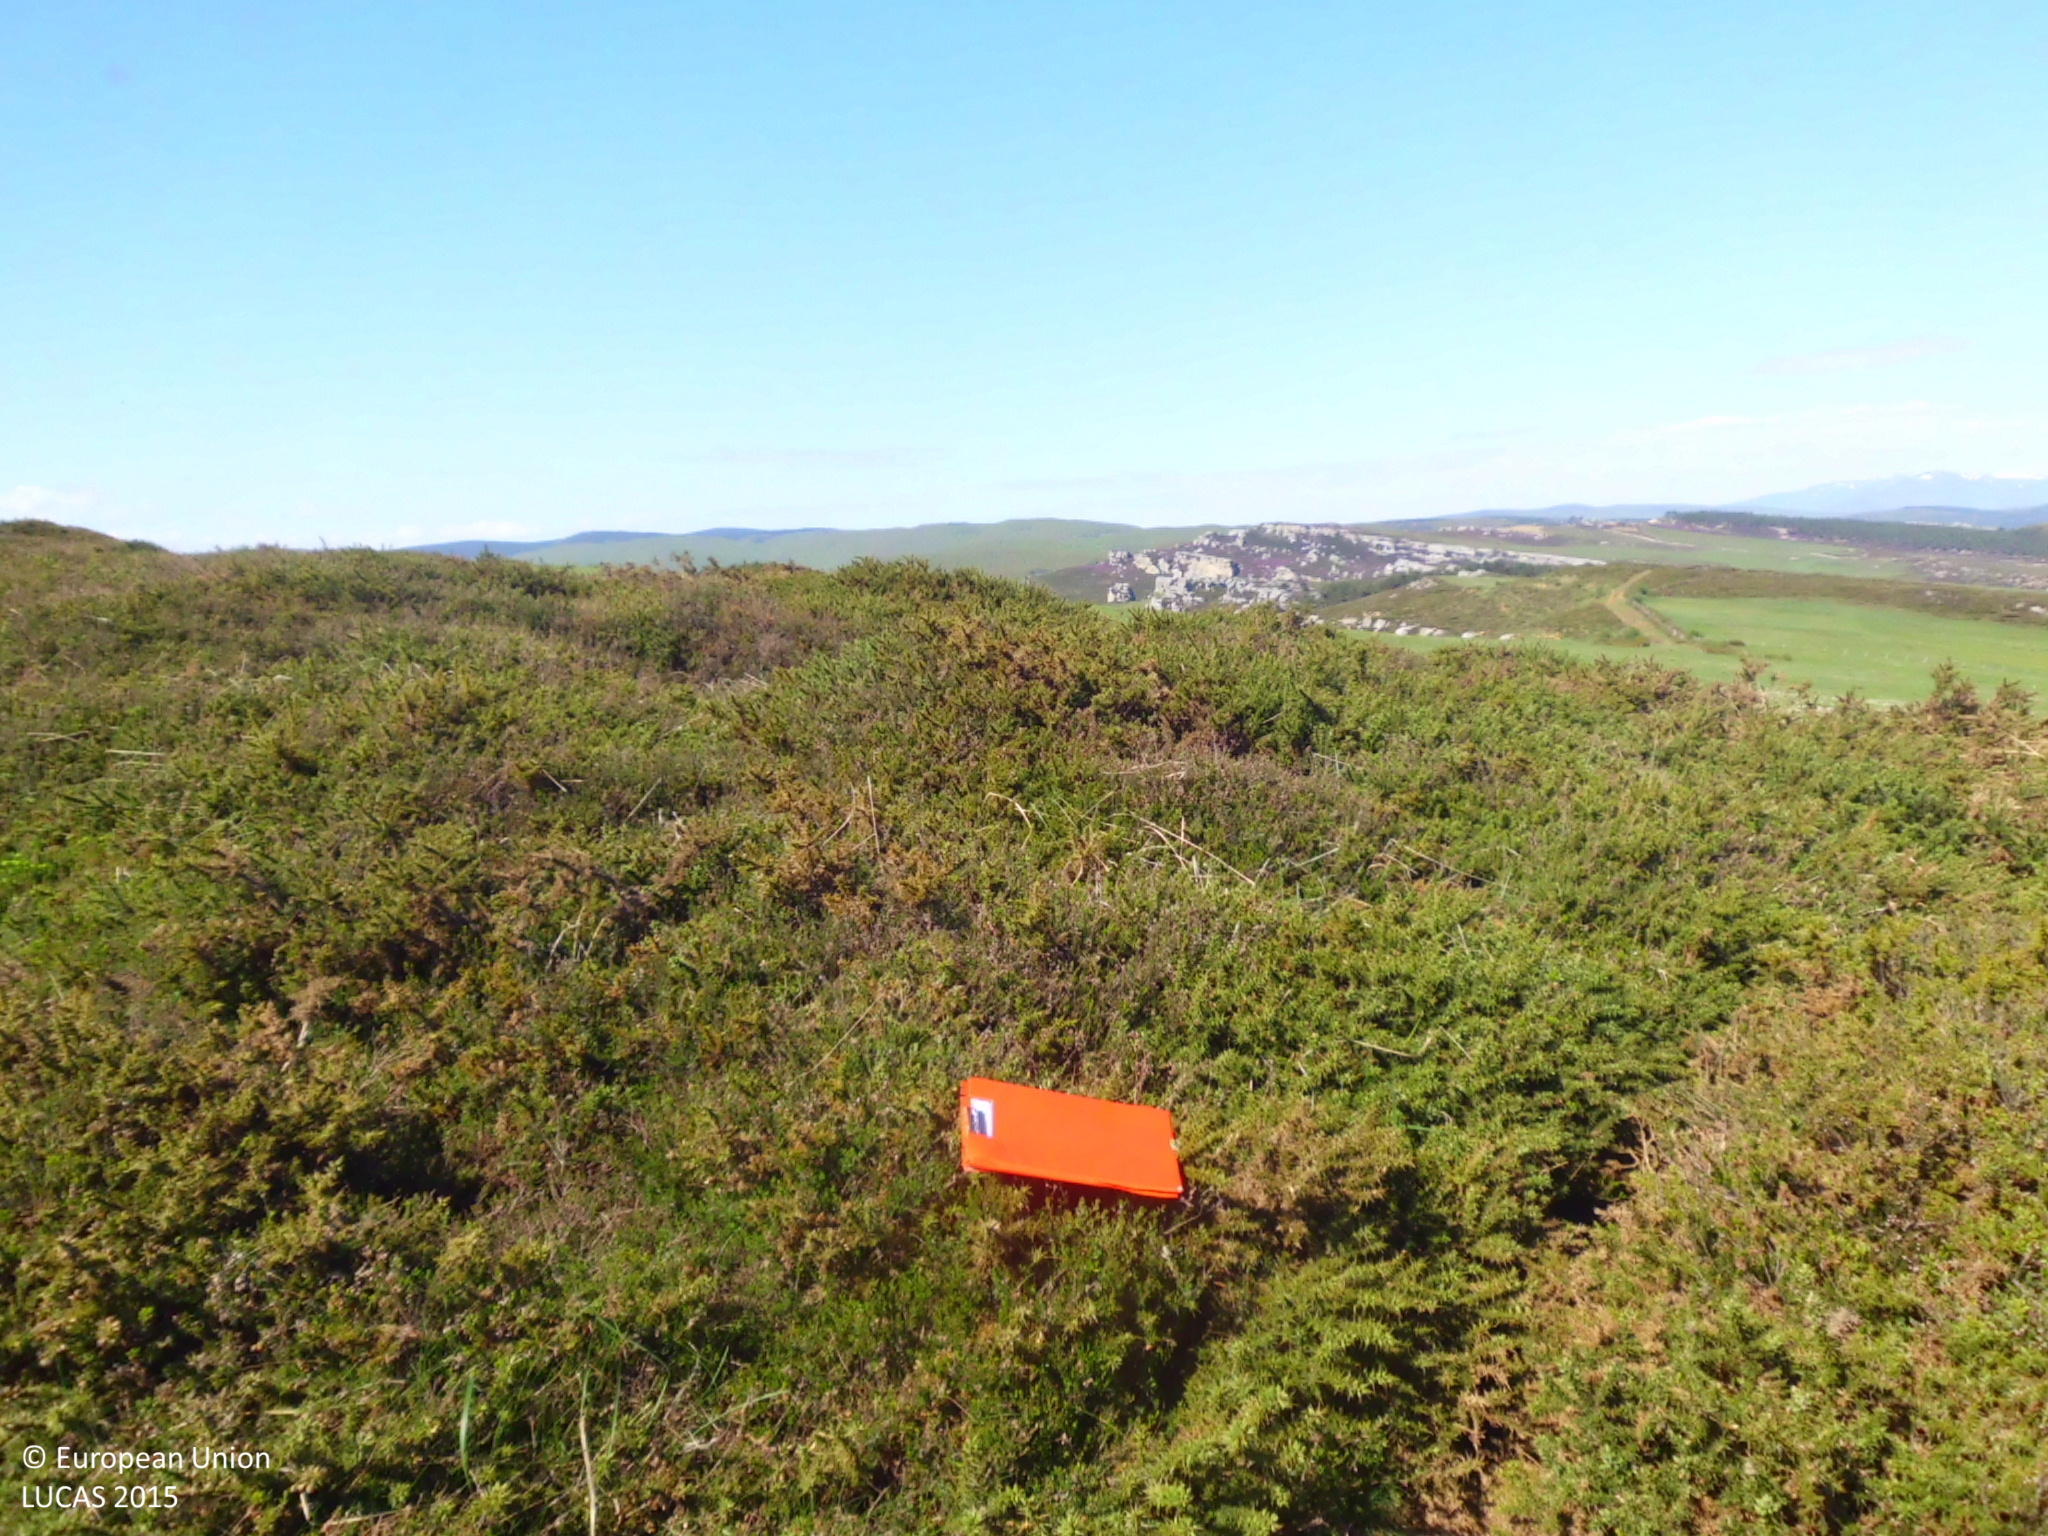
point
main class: Shrubland
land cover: Shrubland without tree cover
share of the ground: > 75 %
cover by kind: shrubs 80 %, herbaceous plants 20 %
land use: Semi-natural and natural areas not in use
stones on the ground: 25 - 50 %
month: May
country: ES
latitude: 42.9338
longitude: -3.9044
